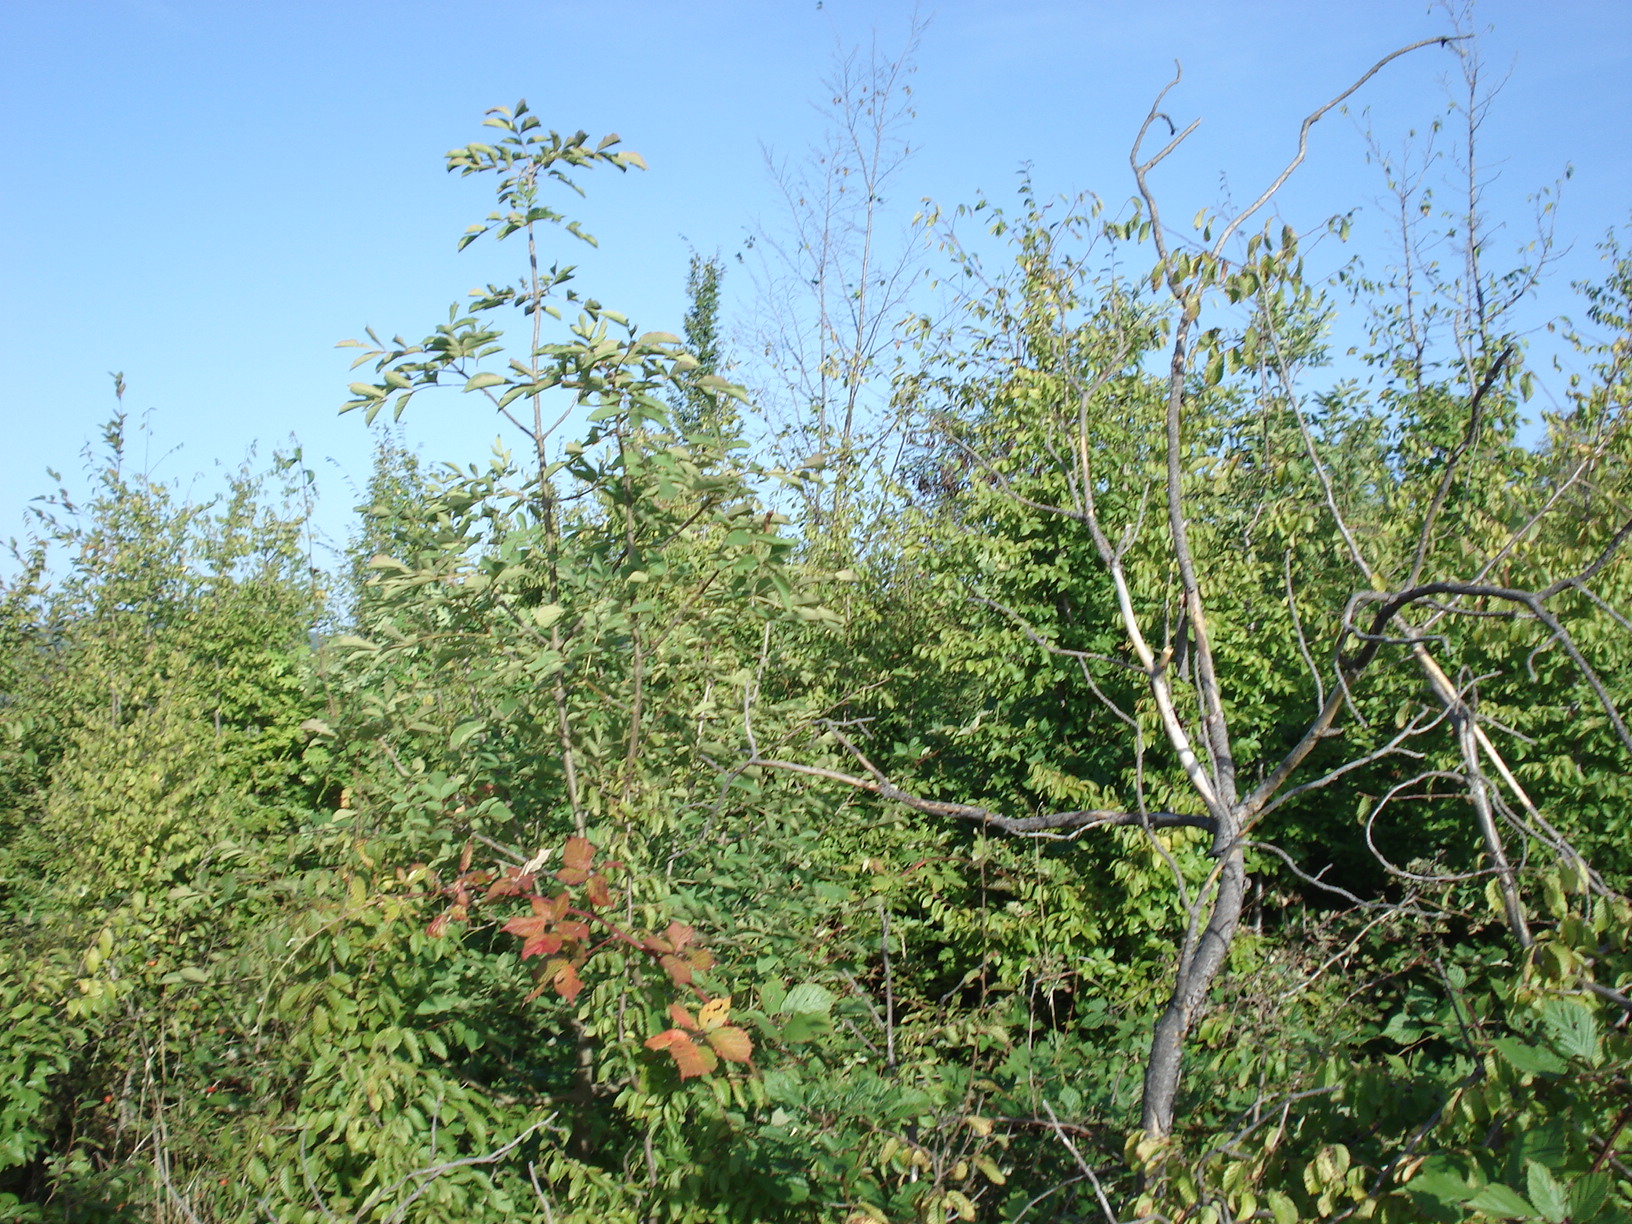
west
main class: Woodland
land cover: Pine dominated mixed woodland
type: hemiboreal forest and nemoral coniferous forest and mixed broadleaved-coniferous forest
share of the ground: 50 - 75 %
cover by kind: coniferous forest trees 35 %, broadleaved forest trees 35 %, shrubs 20 %, herbaceous plants 10 %
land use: Forestry
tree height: < 5 m
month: September
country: BG
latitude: 42.9224
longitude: 25.7248
